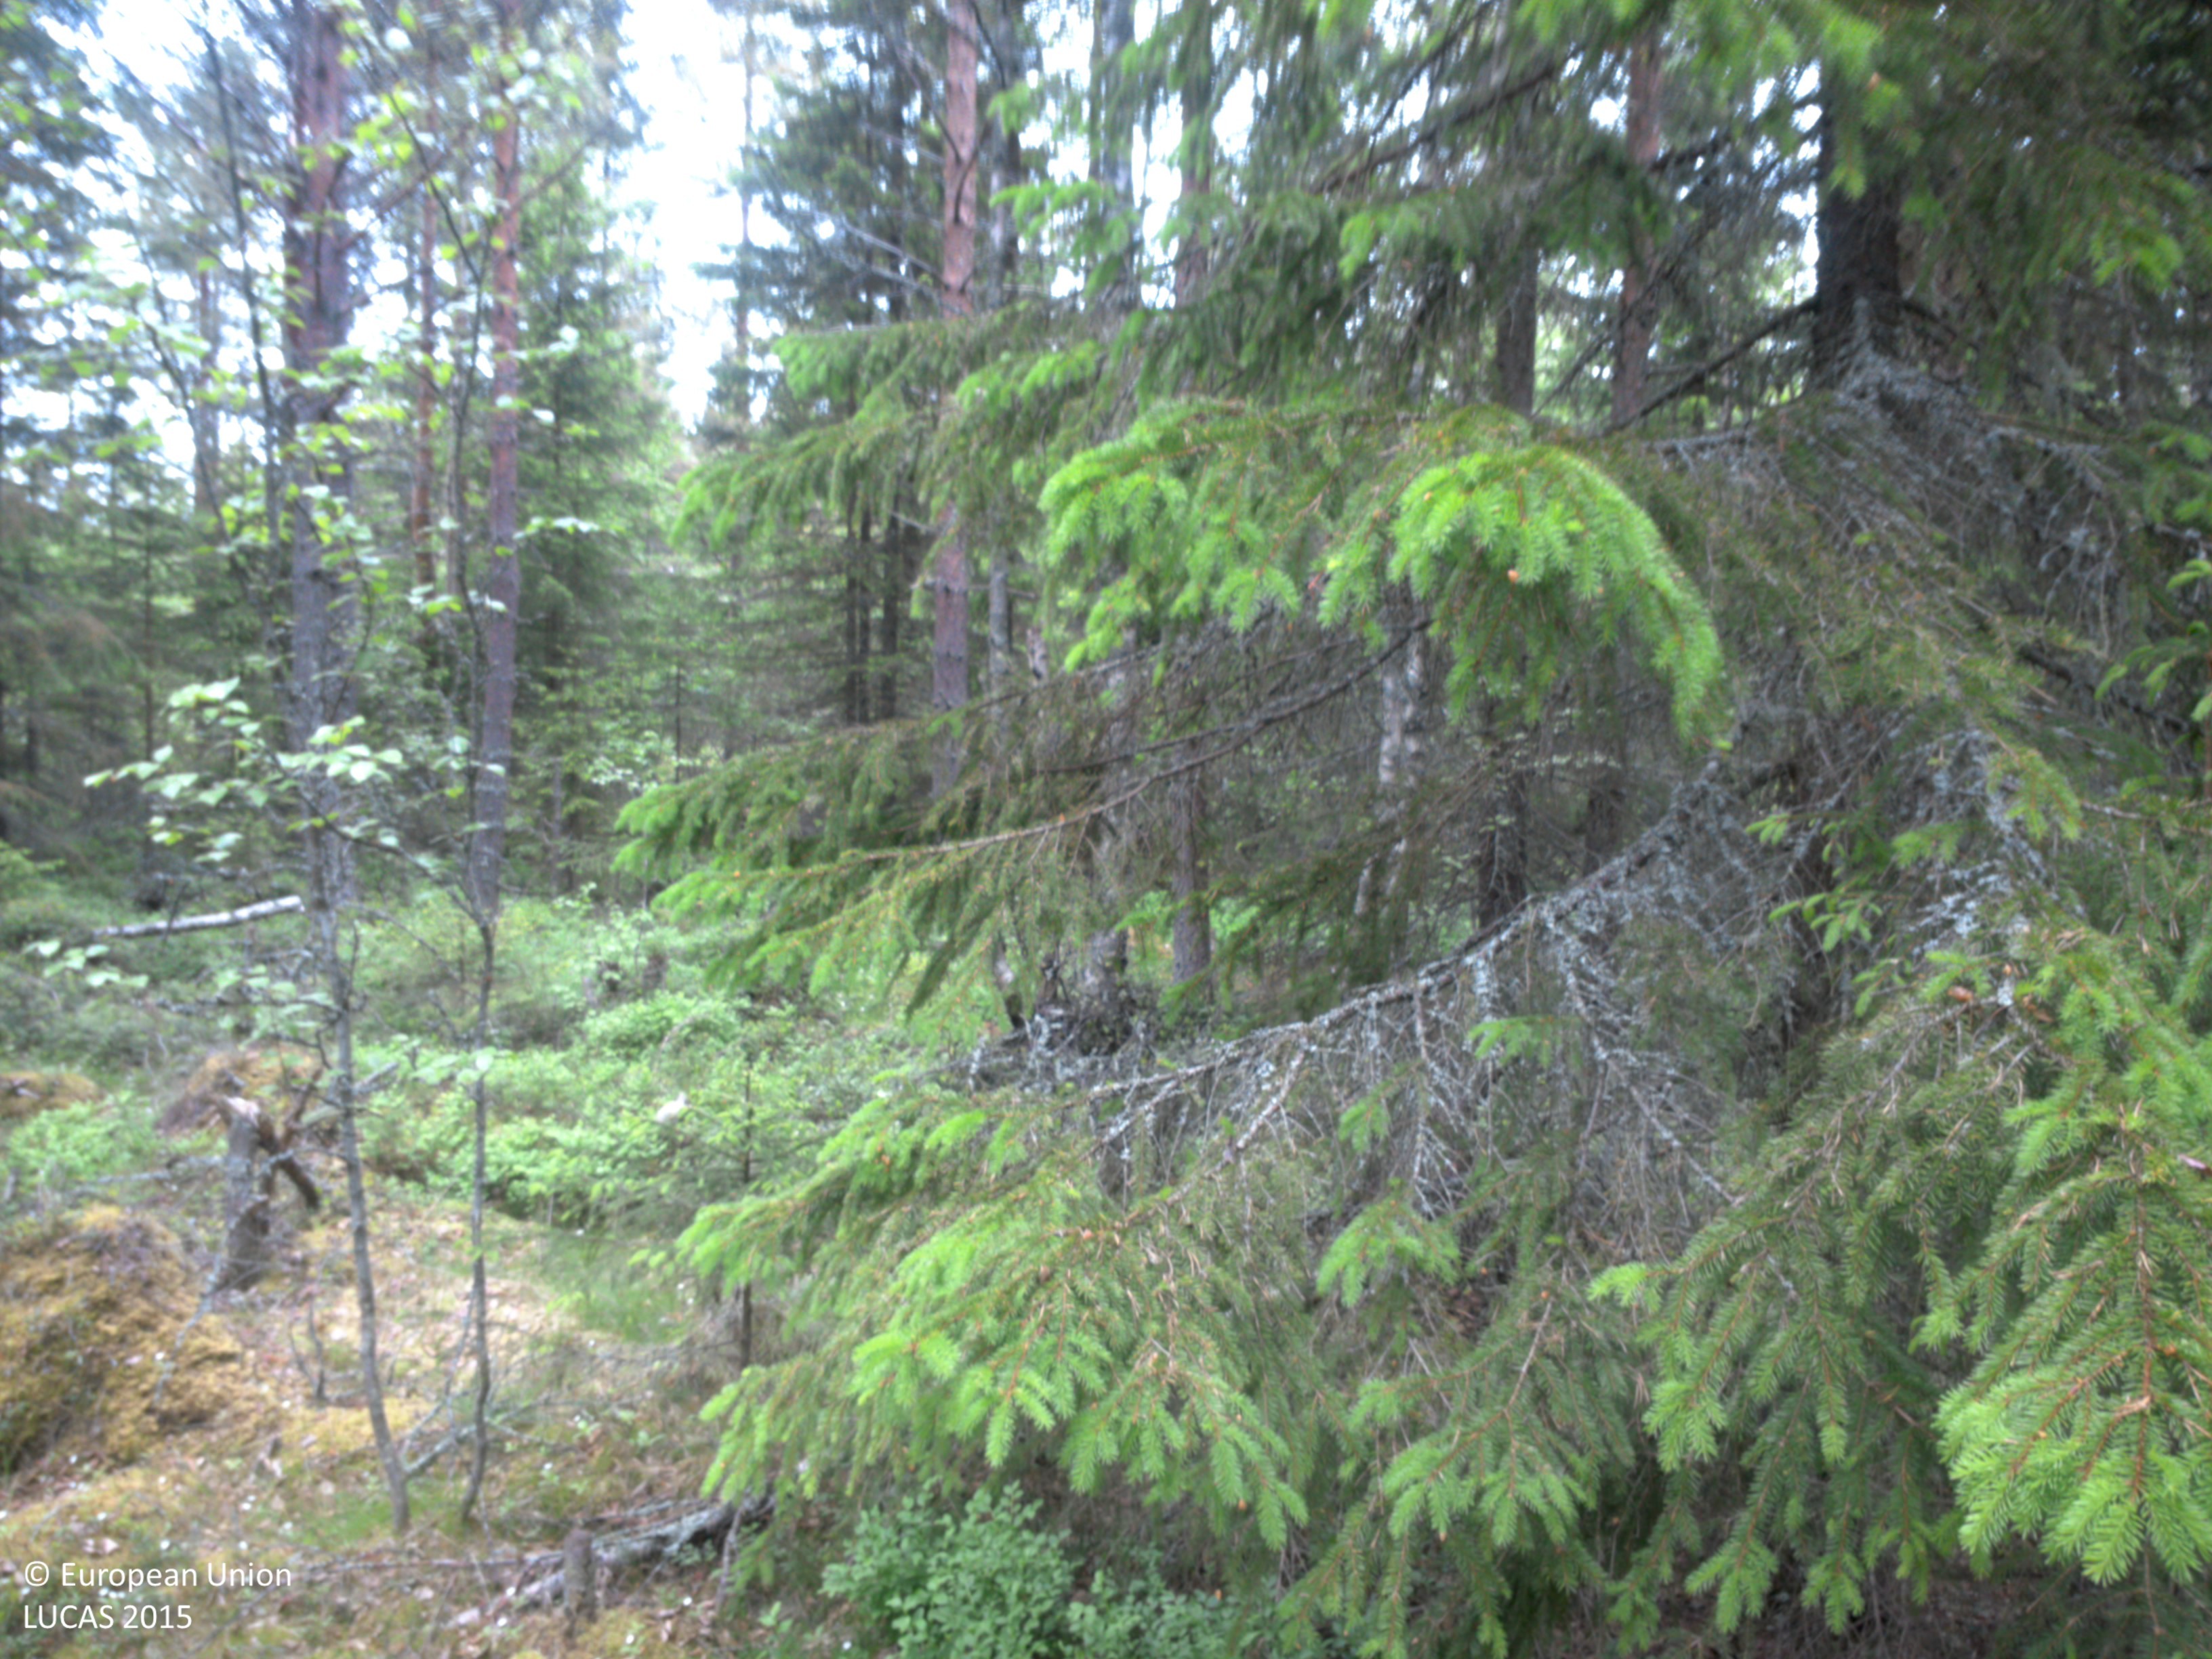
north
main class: Woodland
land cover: Other mixed woodland
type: boreal forest
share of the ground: 50 - 75 %
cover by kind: coniferous forest trees 40 %, broadleaved forest trees 25 %, lichens and mosses 20 %, shrubs 15 %
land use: Forestry
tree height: > 5 m
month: June
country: SE
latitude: 63.6283
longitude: 19.9699
